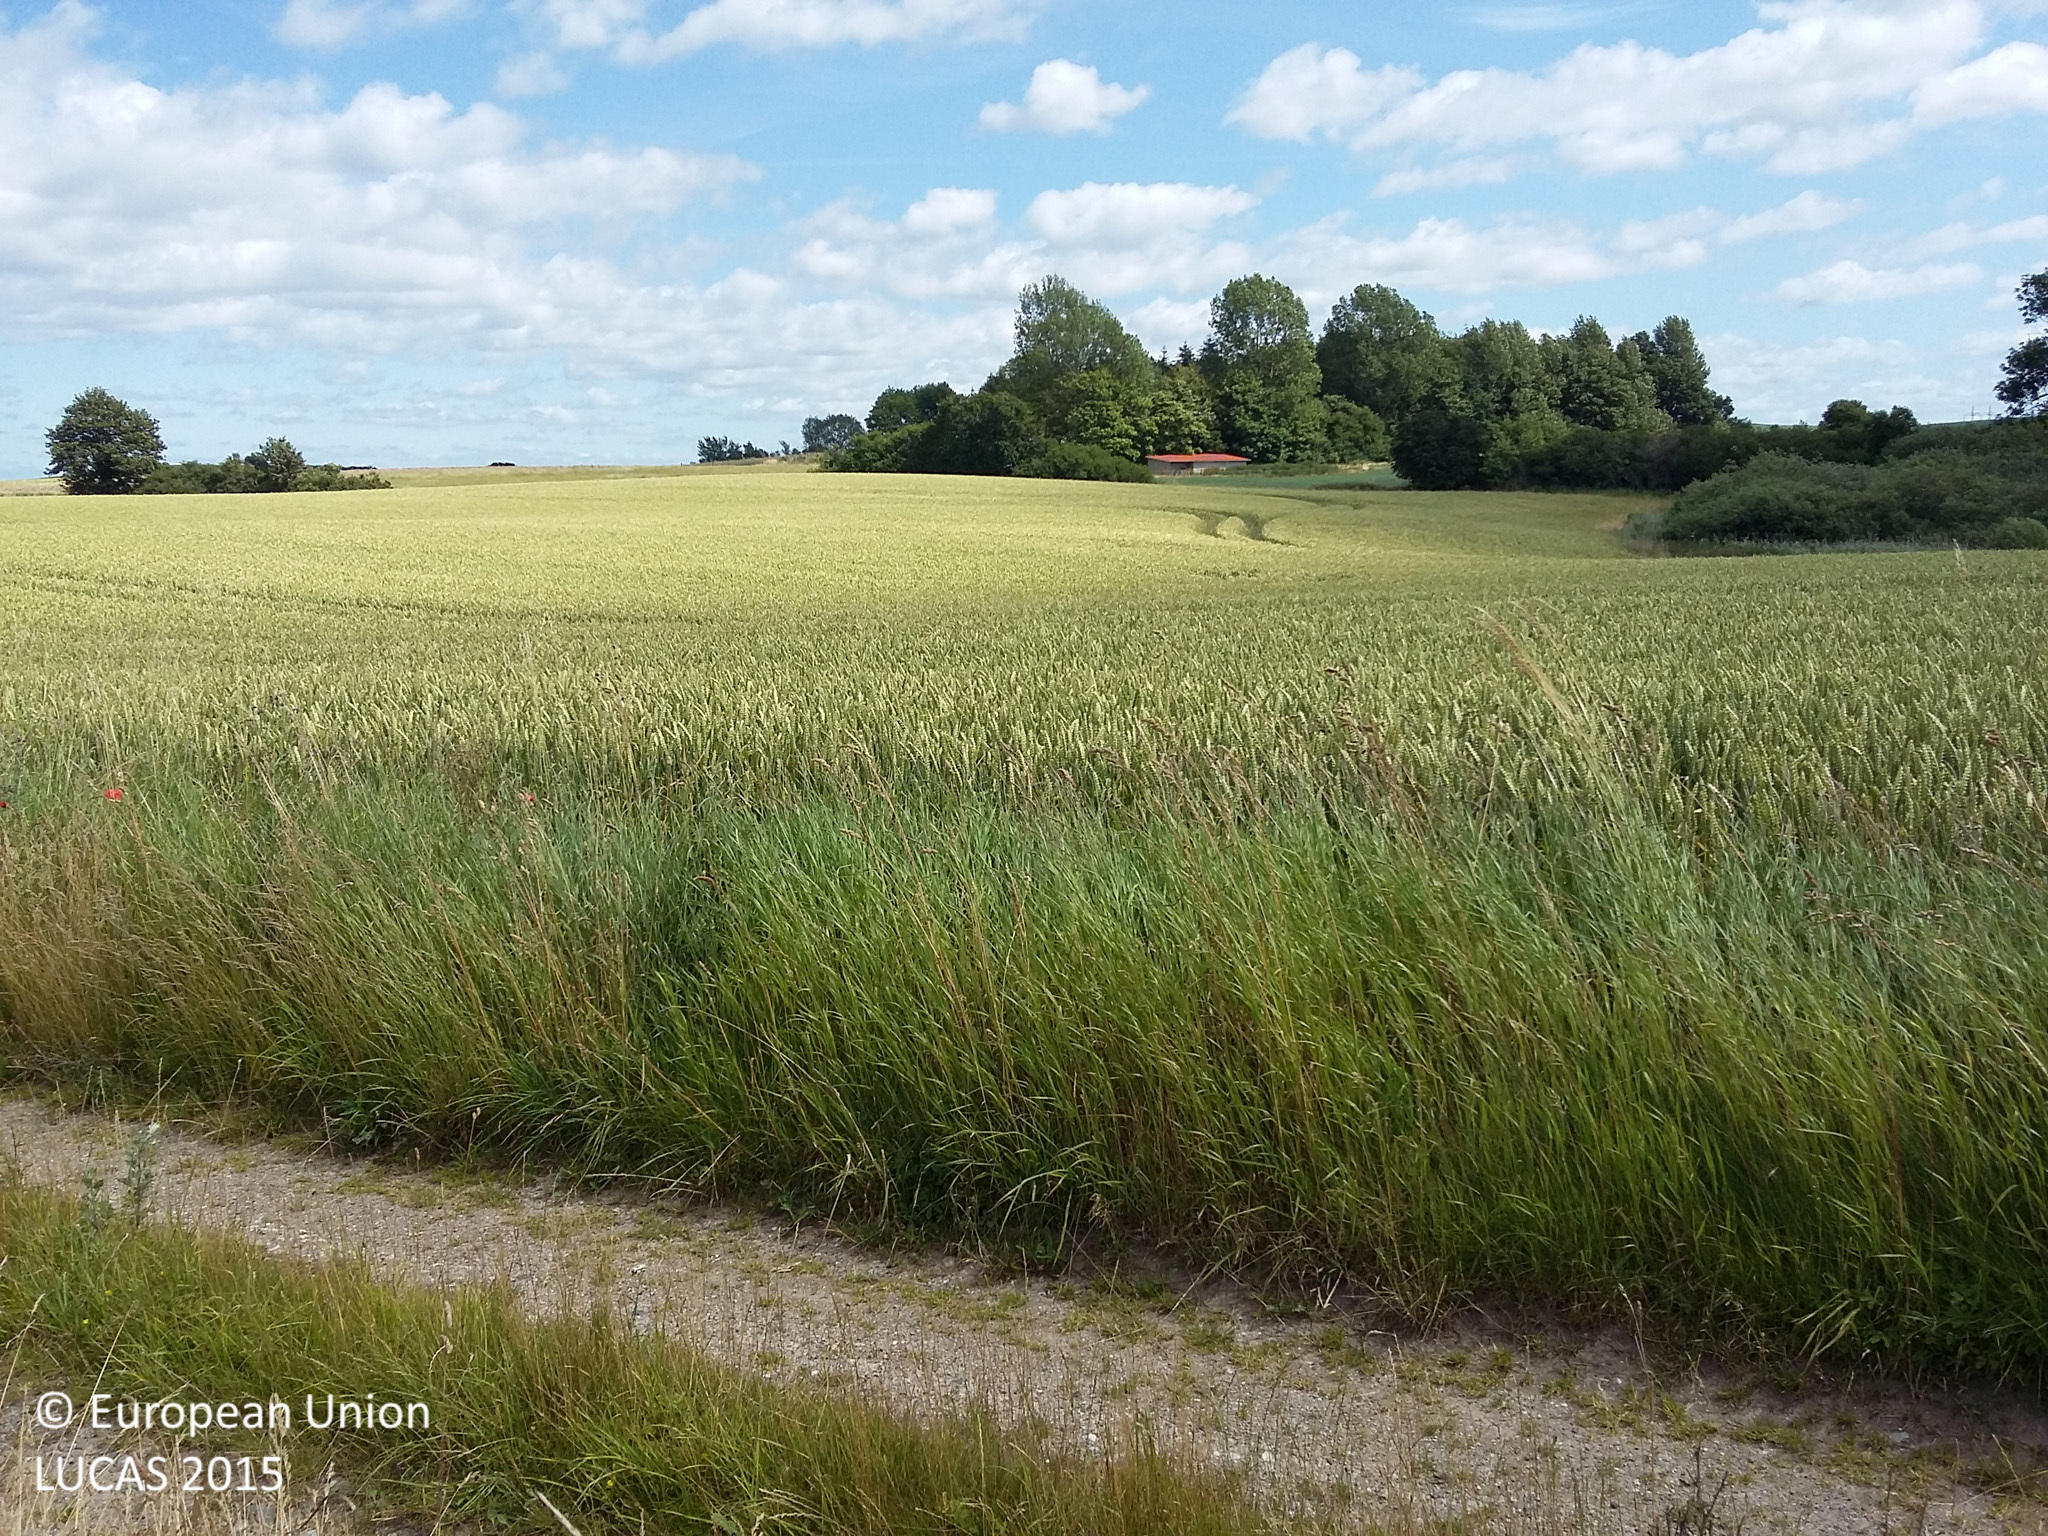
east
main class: Cropland
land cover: Common wheat
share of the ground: > 75 %
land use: Agriculture (excluding fallow land and kitchen gardens)
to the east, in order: Common wheat; Shruby margins; Tracks; Shruby margins; Common wheat
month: July
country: DK
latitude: 55.6240
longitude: 11.2851
